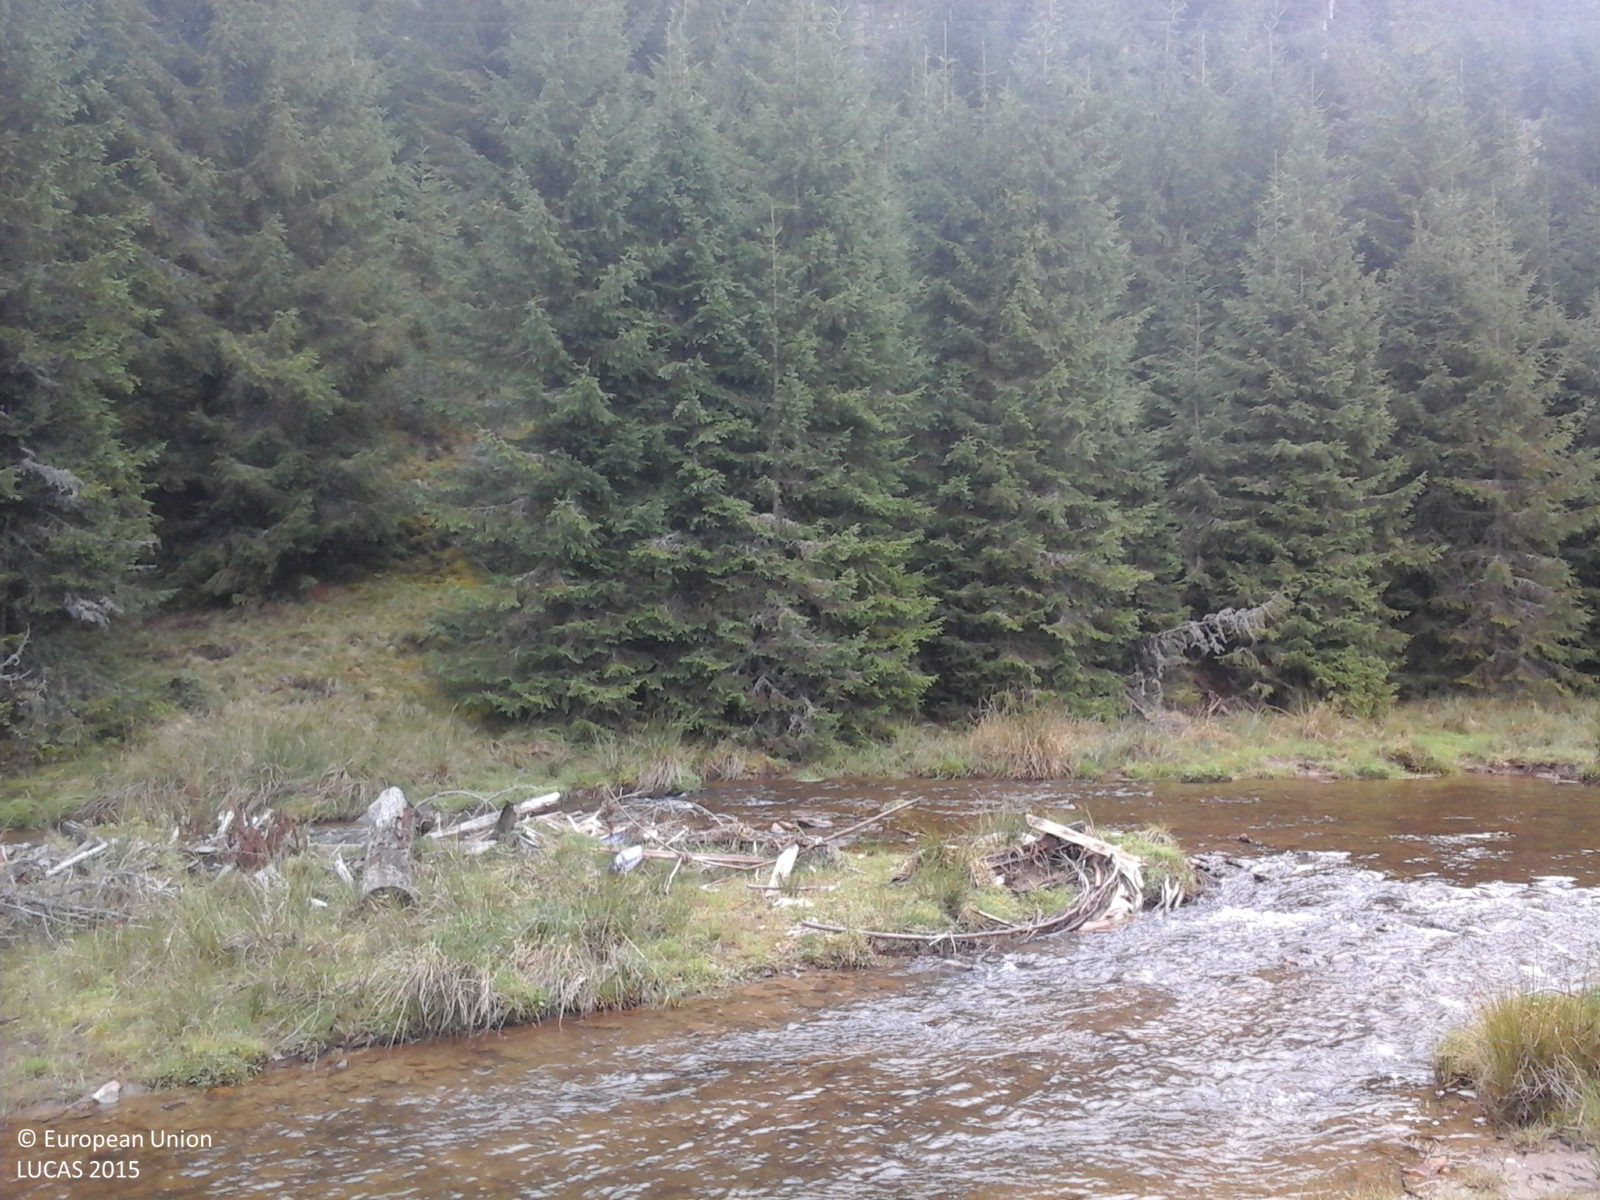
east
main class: Woodland
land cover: Spruce dominated coniferous woodland
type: alpine coniferous forest
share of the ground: > 75 %
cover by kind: coniferous forest trees 100 %
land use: Forestry
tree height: > 5 m
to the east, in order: Spruce dominated coniferous woodland
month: September
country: RO
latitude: 46.5698
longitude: 23.0421
